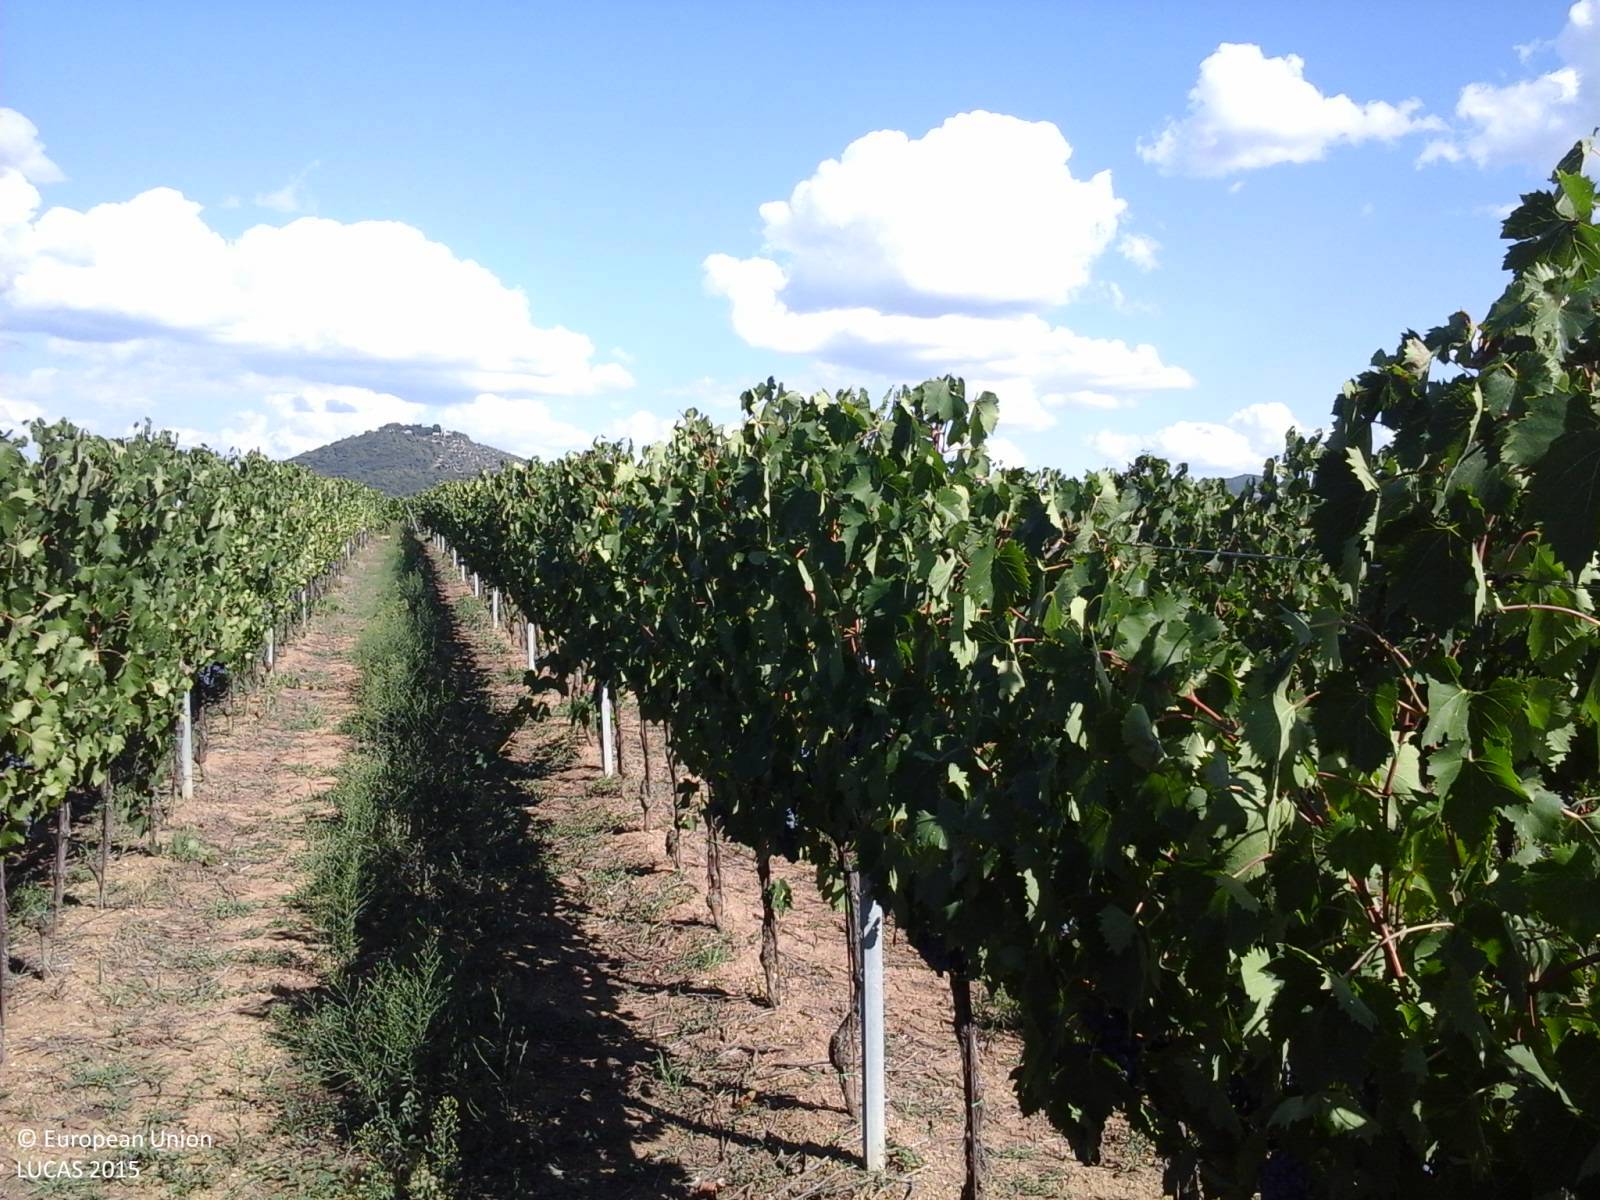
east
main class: Cropland
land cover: Vineyards
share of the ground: 25 - 50 %
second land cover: Spontaneously vegetated surfaces
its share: > 75 %
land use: Agriculture (excluding fallow land and kitchen gardens)
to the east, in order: Vineyards; Spontaneously vegetated surfaces; Tracks; Vineyards; Grass margins; Paved roads, cycling and walking lanes; Grass margins; Vineyards
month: September
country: IT
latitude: 43.0659
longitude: 12.0936
